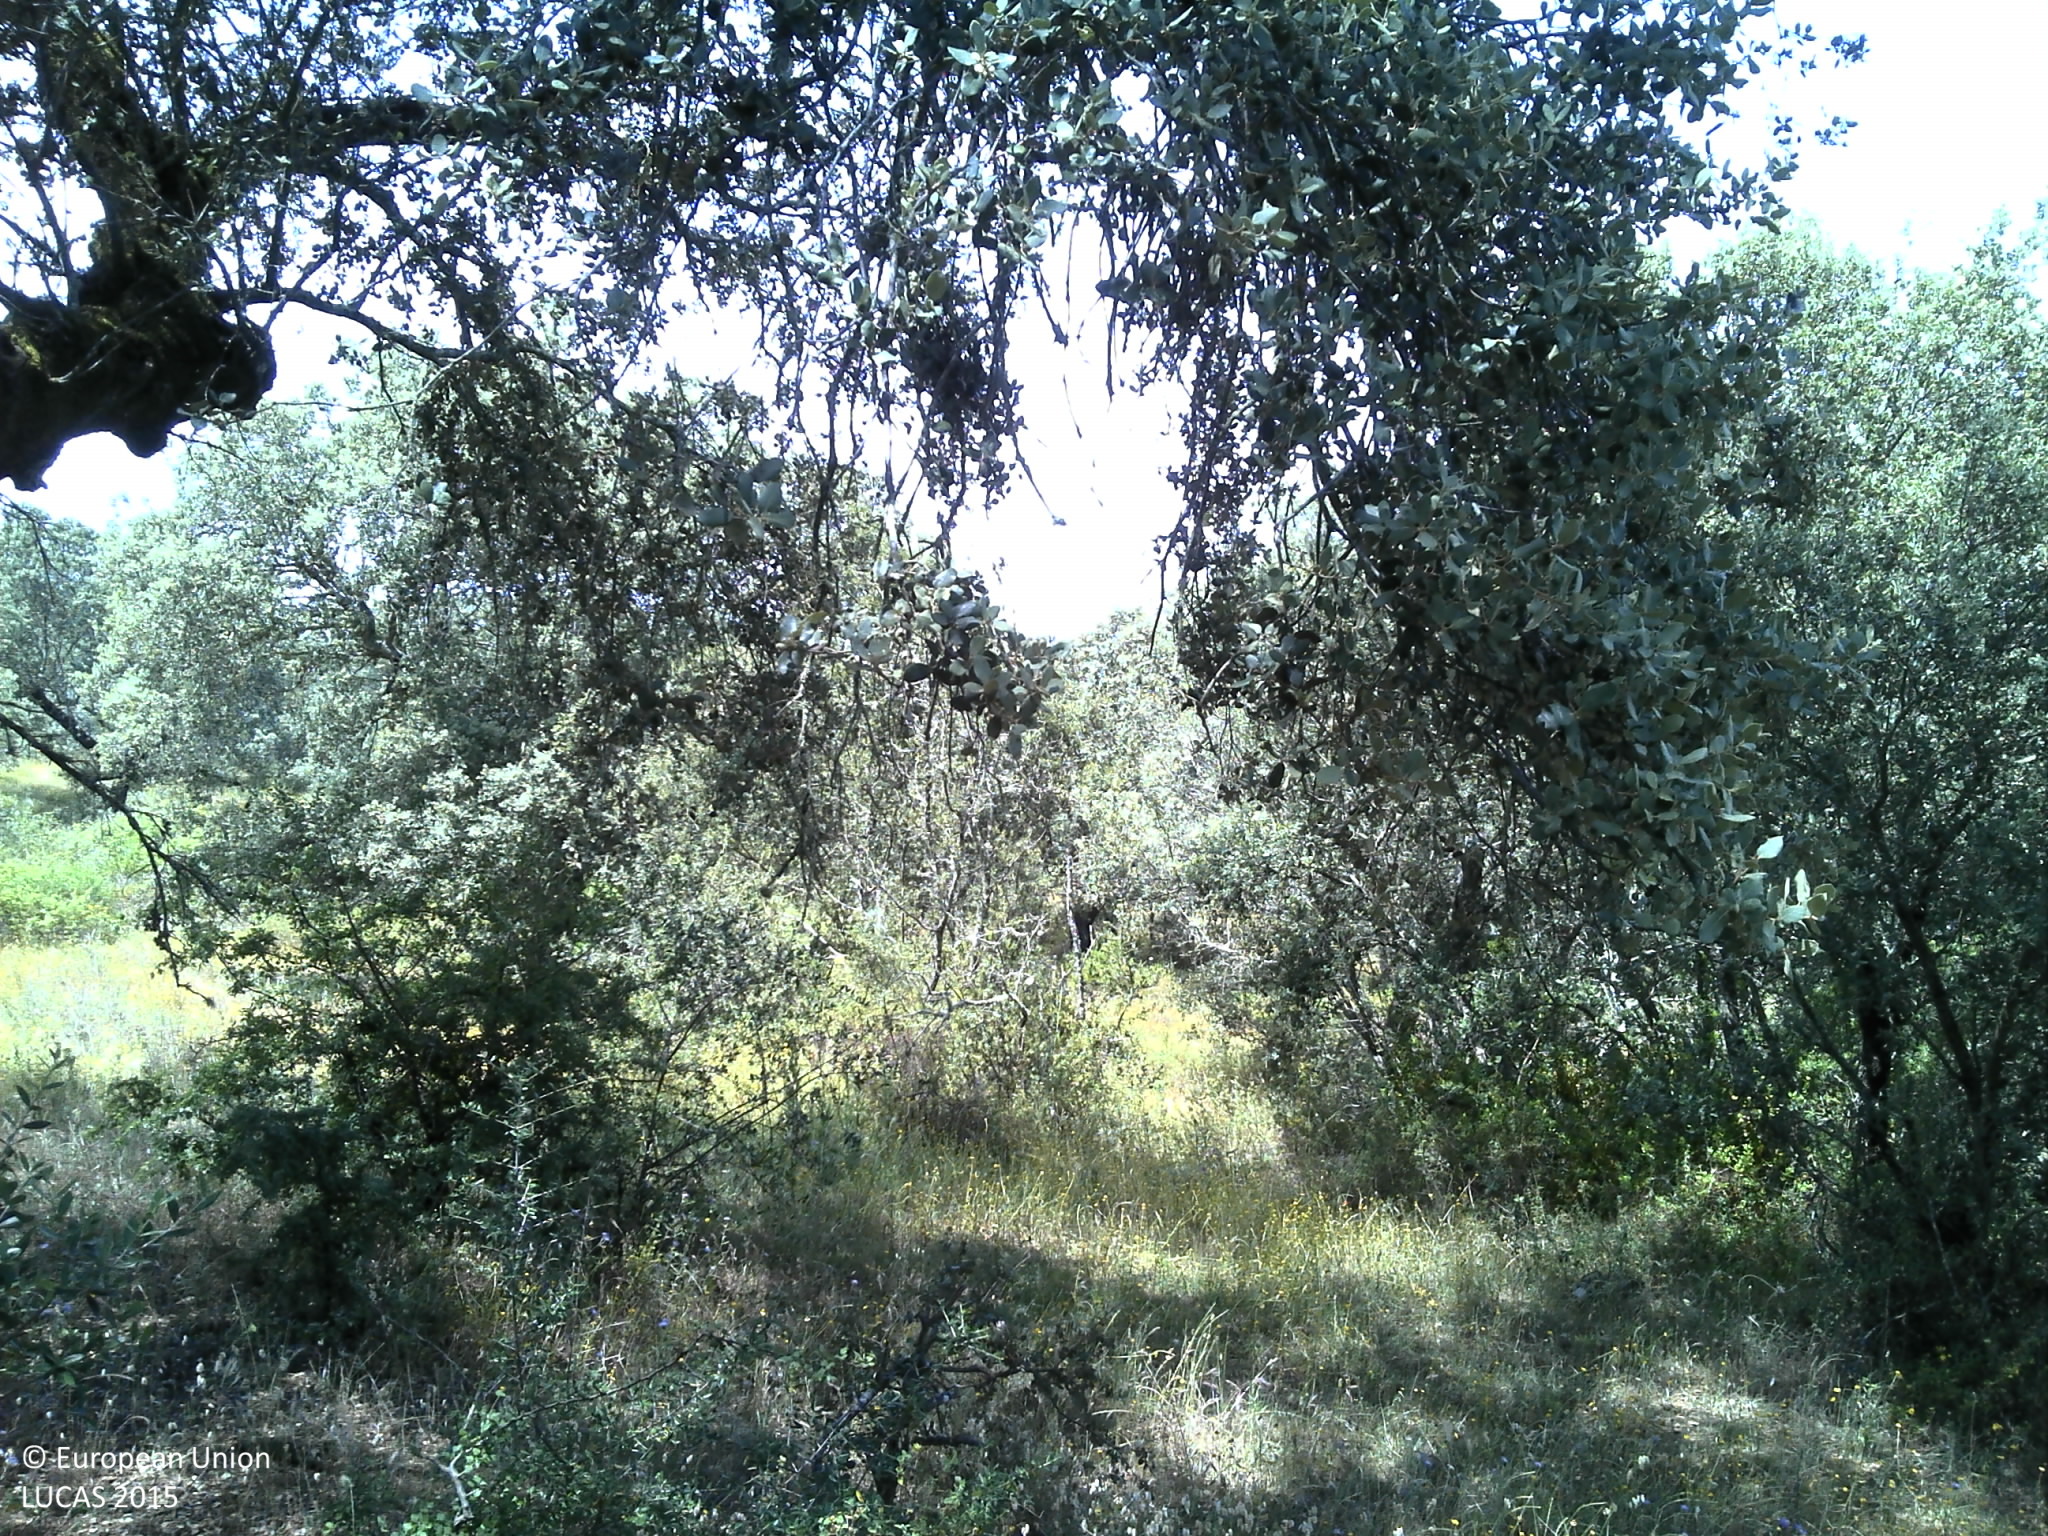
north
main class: Woodland
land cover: Broadleaved woodland
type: broadleaved evergreen forest
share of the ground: 50 - 75 %
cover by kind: broadleaved forest trees 60 %, shrubs 30 %, herbaceous plants 10 %
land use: Forestry
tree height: > 5 m
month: May
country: PT
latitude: 39.1743
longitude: -7.6266
